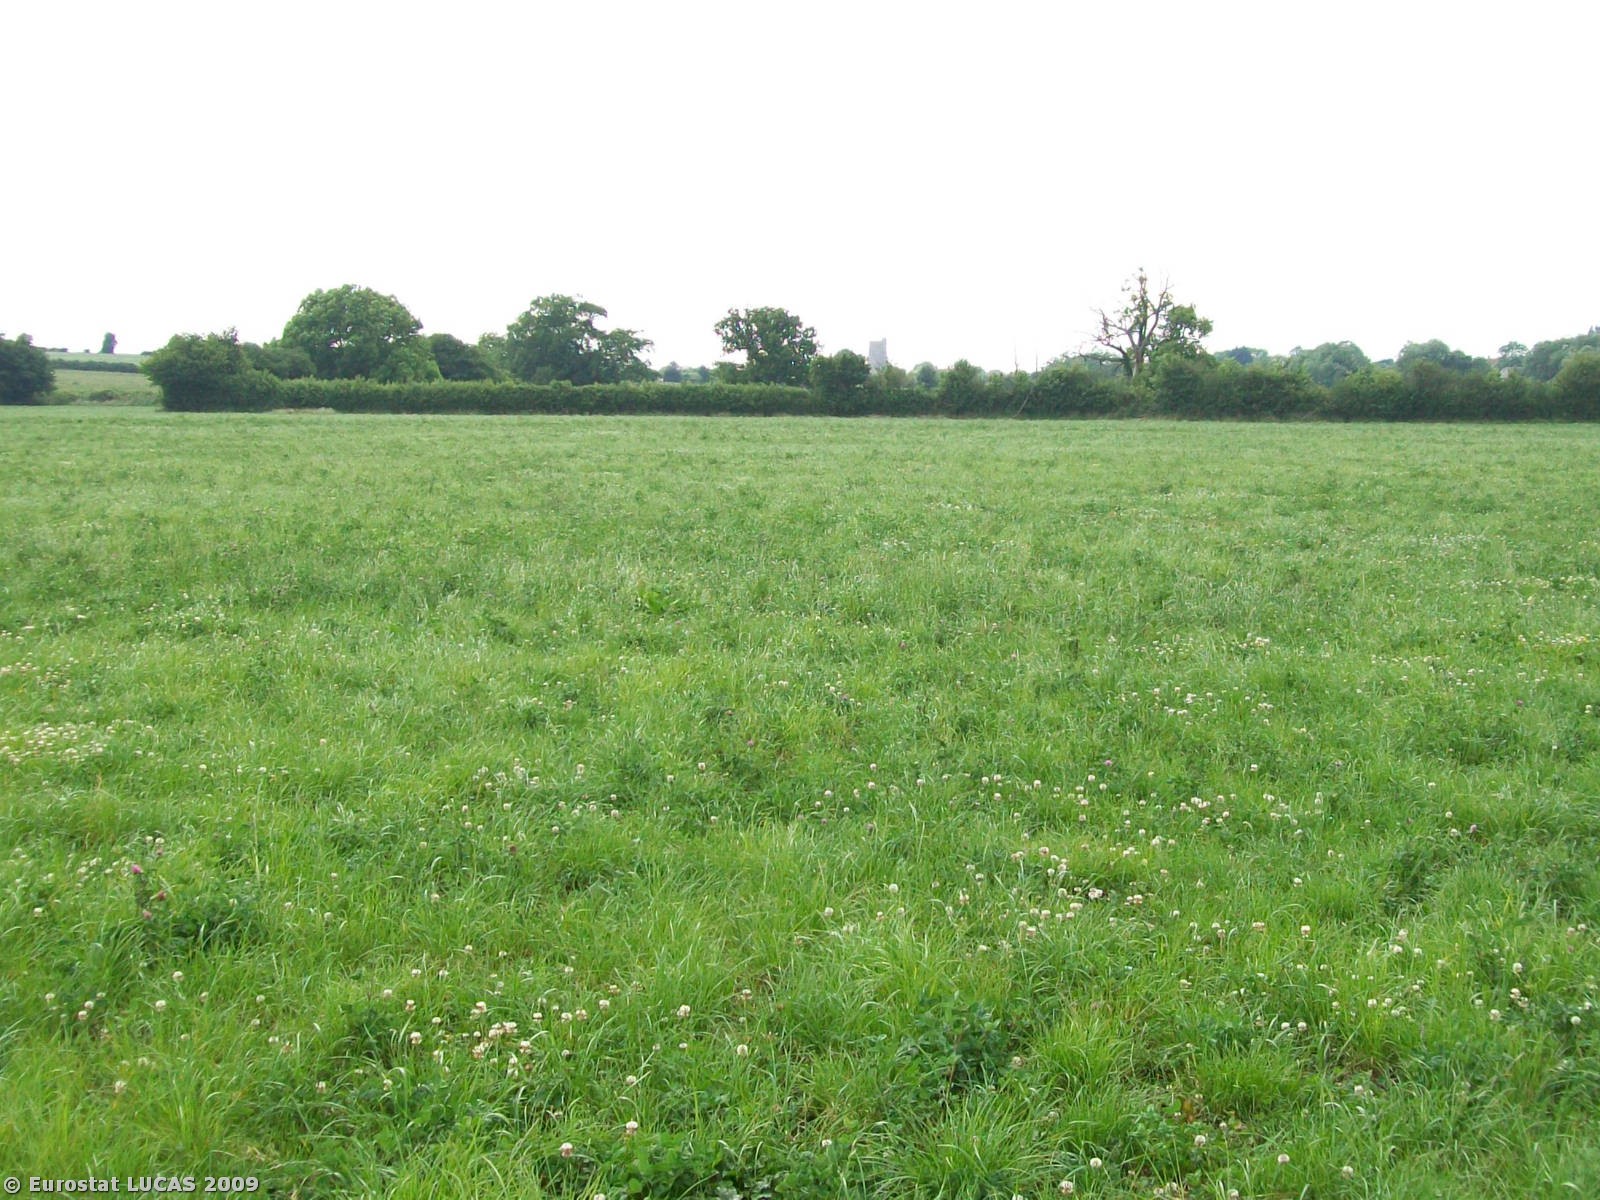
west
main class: Grassland
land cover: Grassland without tree/shrub cover
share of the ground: > 75 %
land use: Agriculture (excluding fallow land and kitchen gardens)
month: June
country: GB
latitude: 51.2838
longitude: -2.2639
